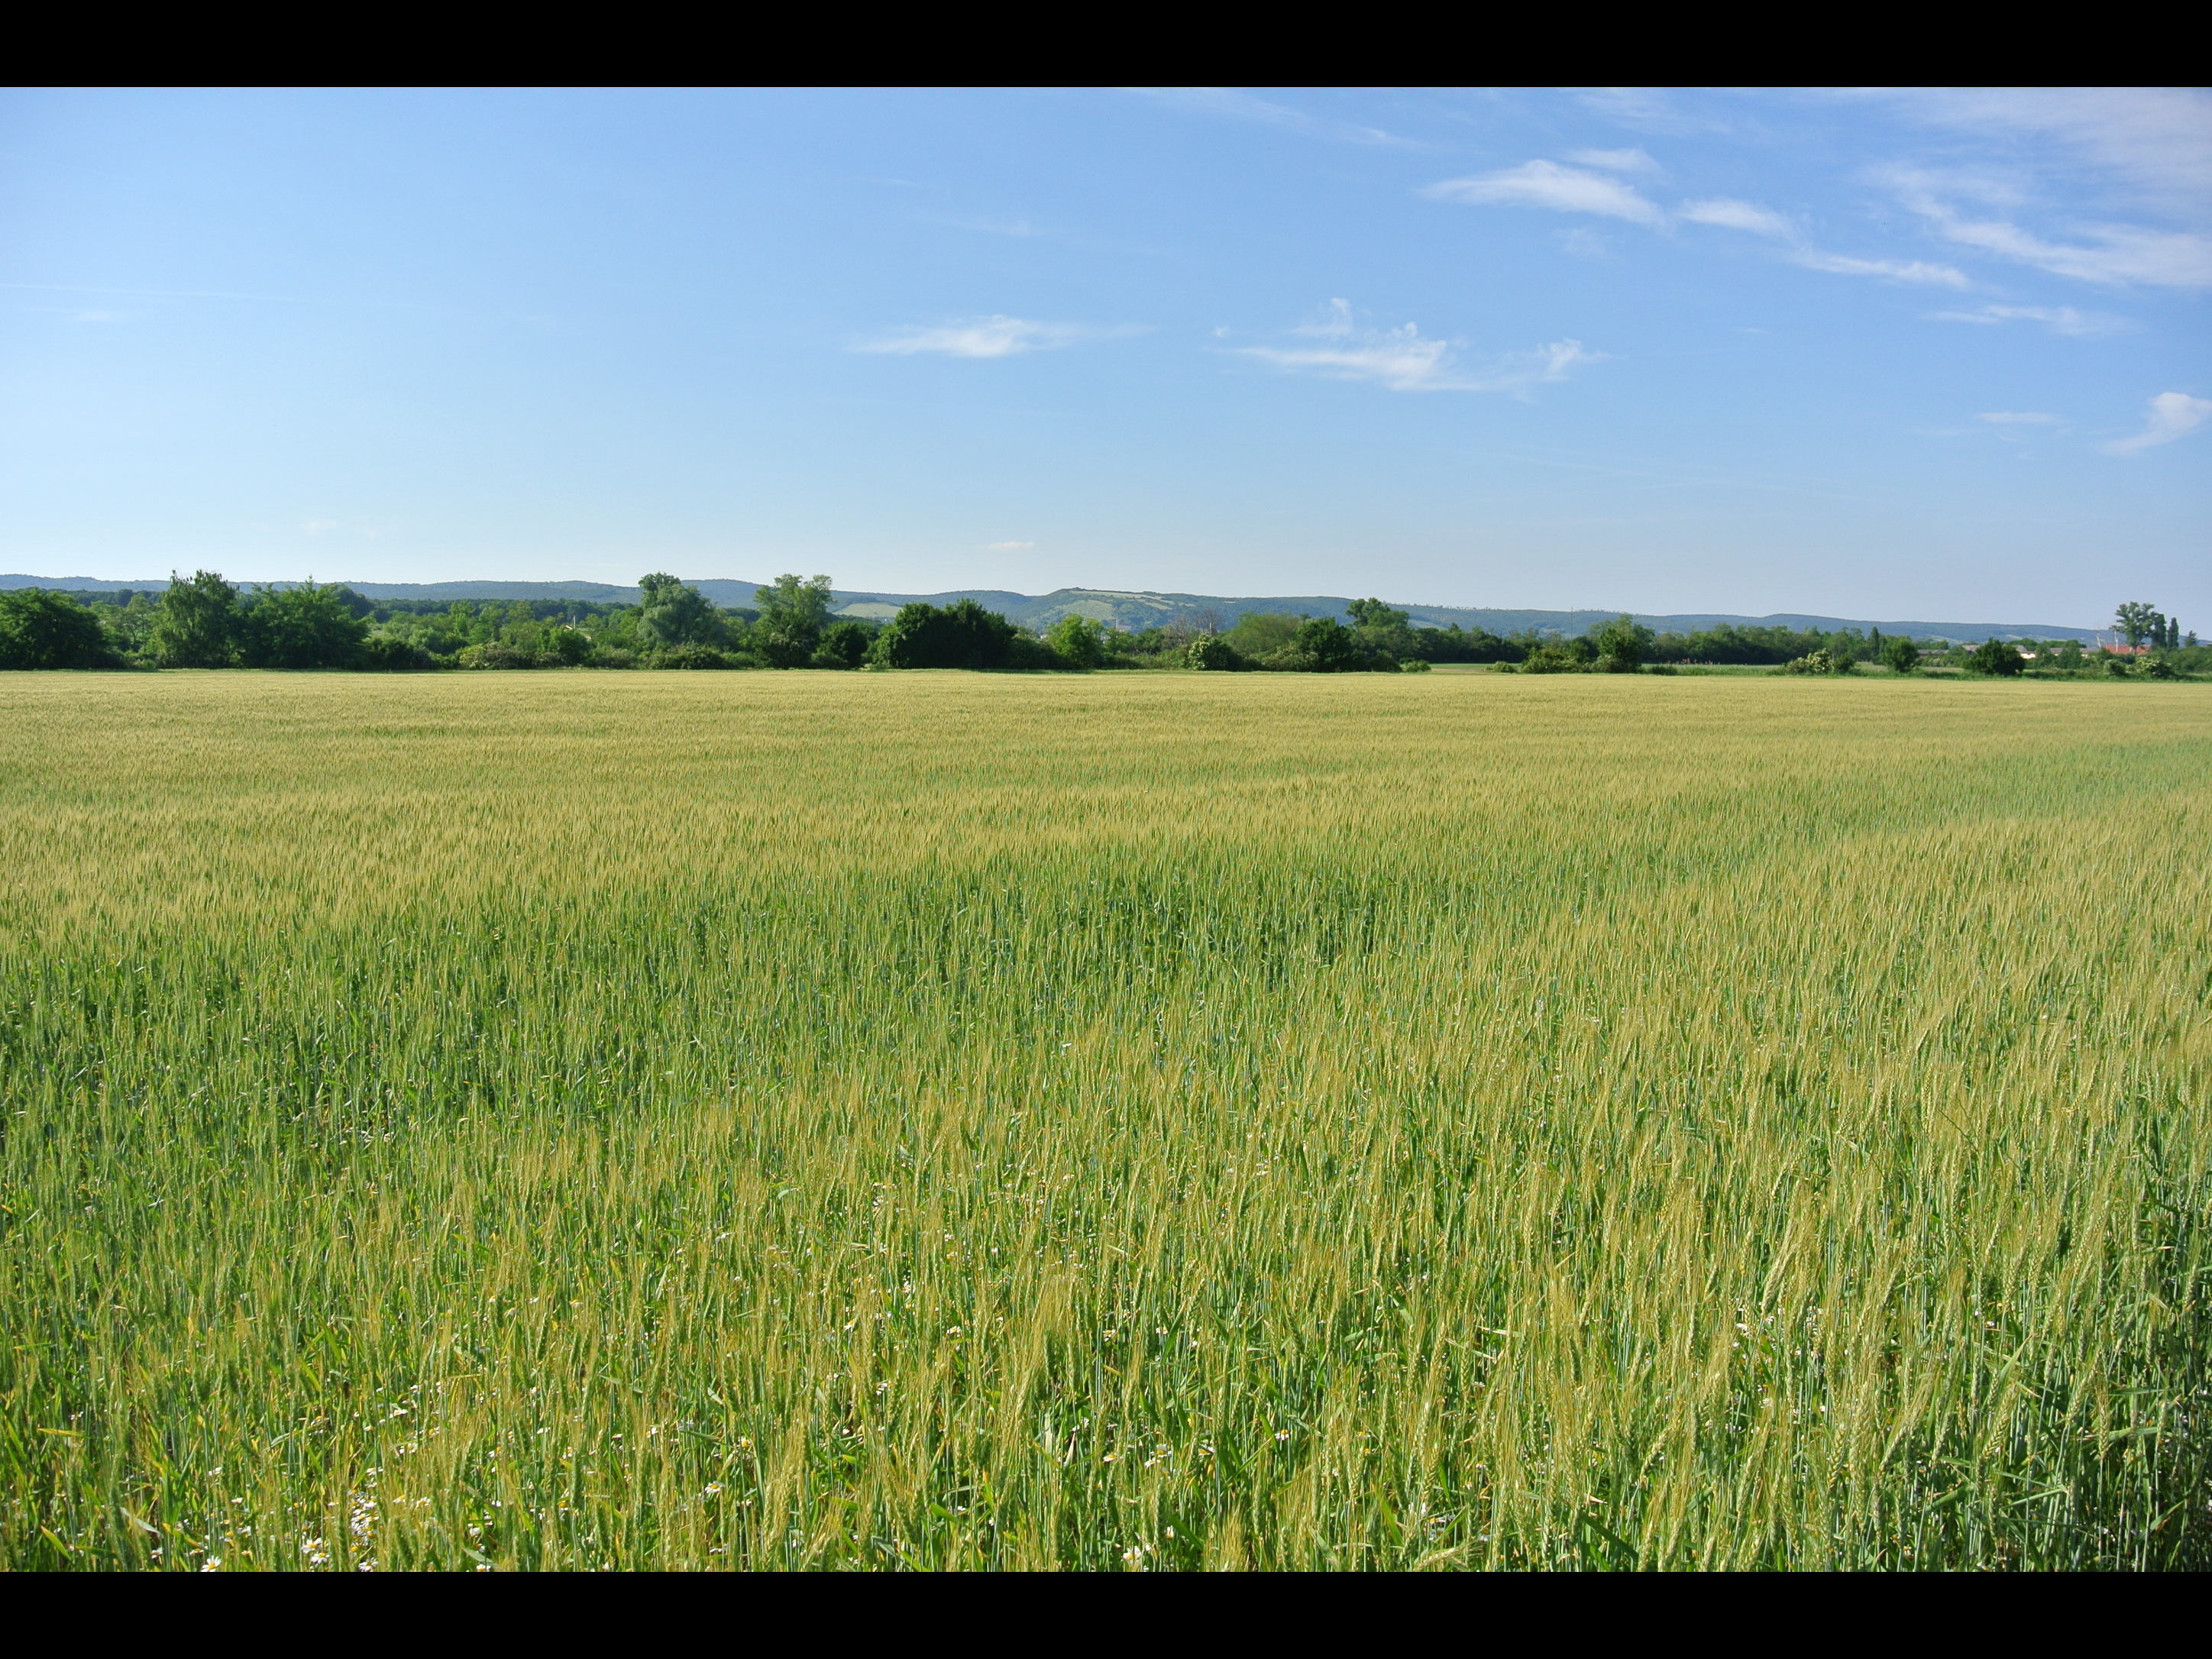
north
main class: Cropland
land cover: Triticale
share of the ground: > 75 %
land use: Agriculture (excluding fallow land and kitchen gardens)
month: June
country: AT
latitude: 47.8603
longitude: 16.6485
